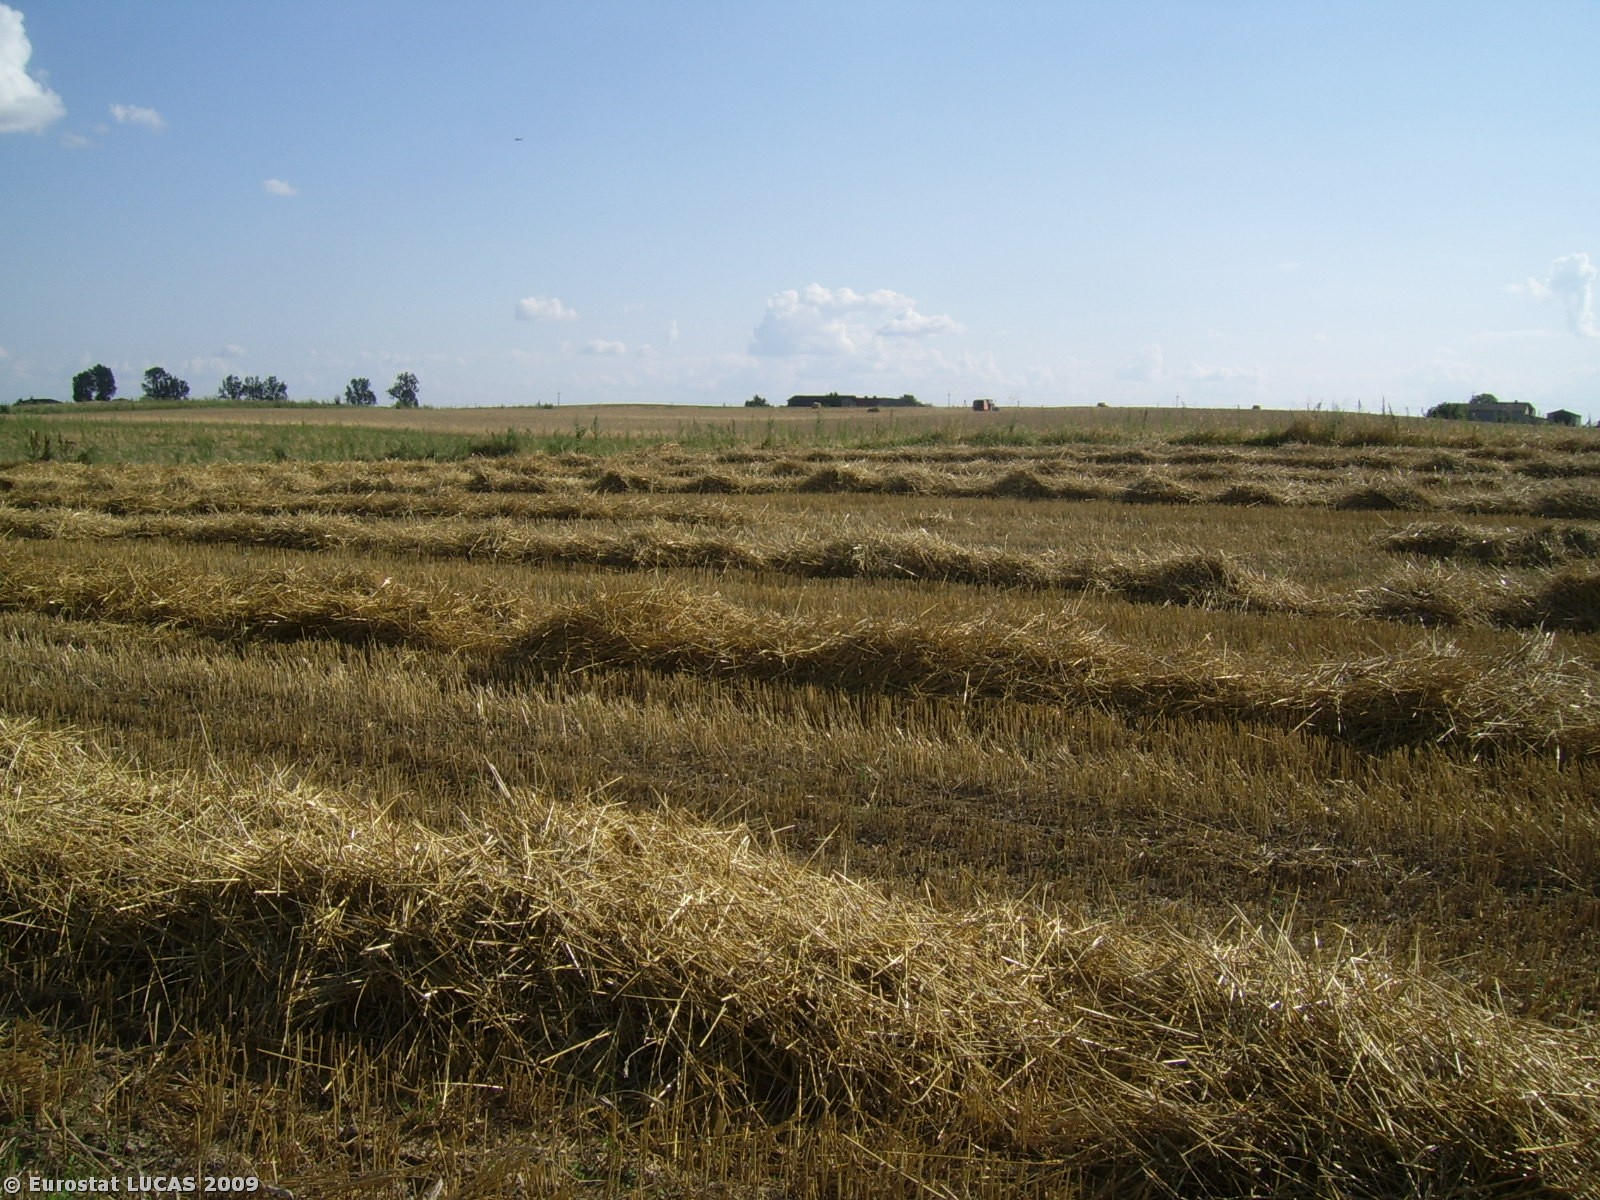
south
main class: Cropland
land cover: Barley
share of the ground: < 10 %
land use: Agriculture (excluding fallow land and kitchen gardens)
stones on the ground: < 10 %
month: August
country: PL
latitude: 53.1023
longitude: 18.7582
